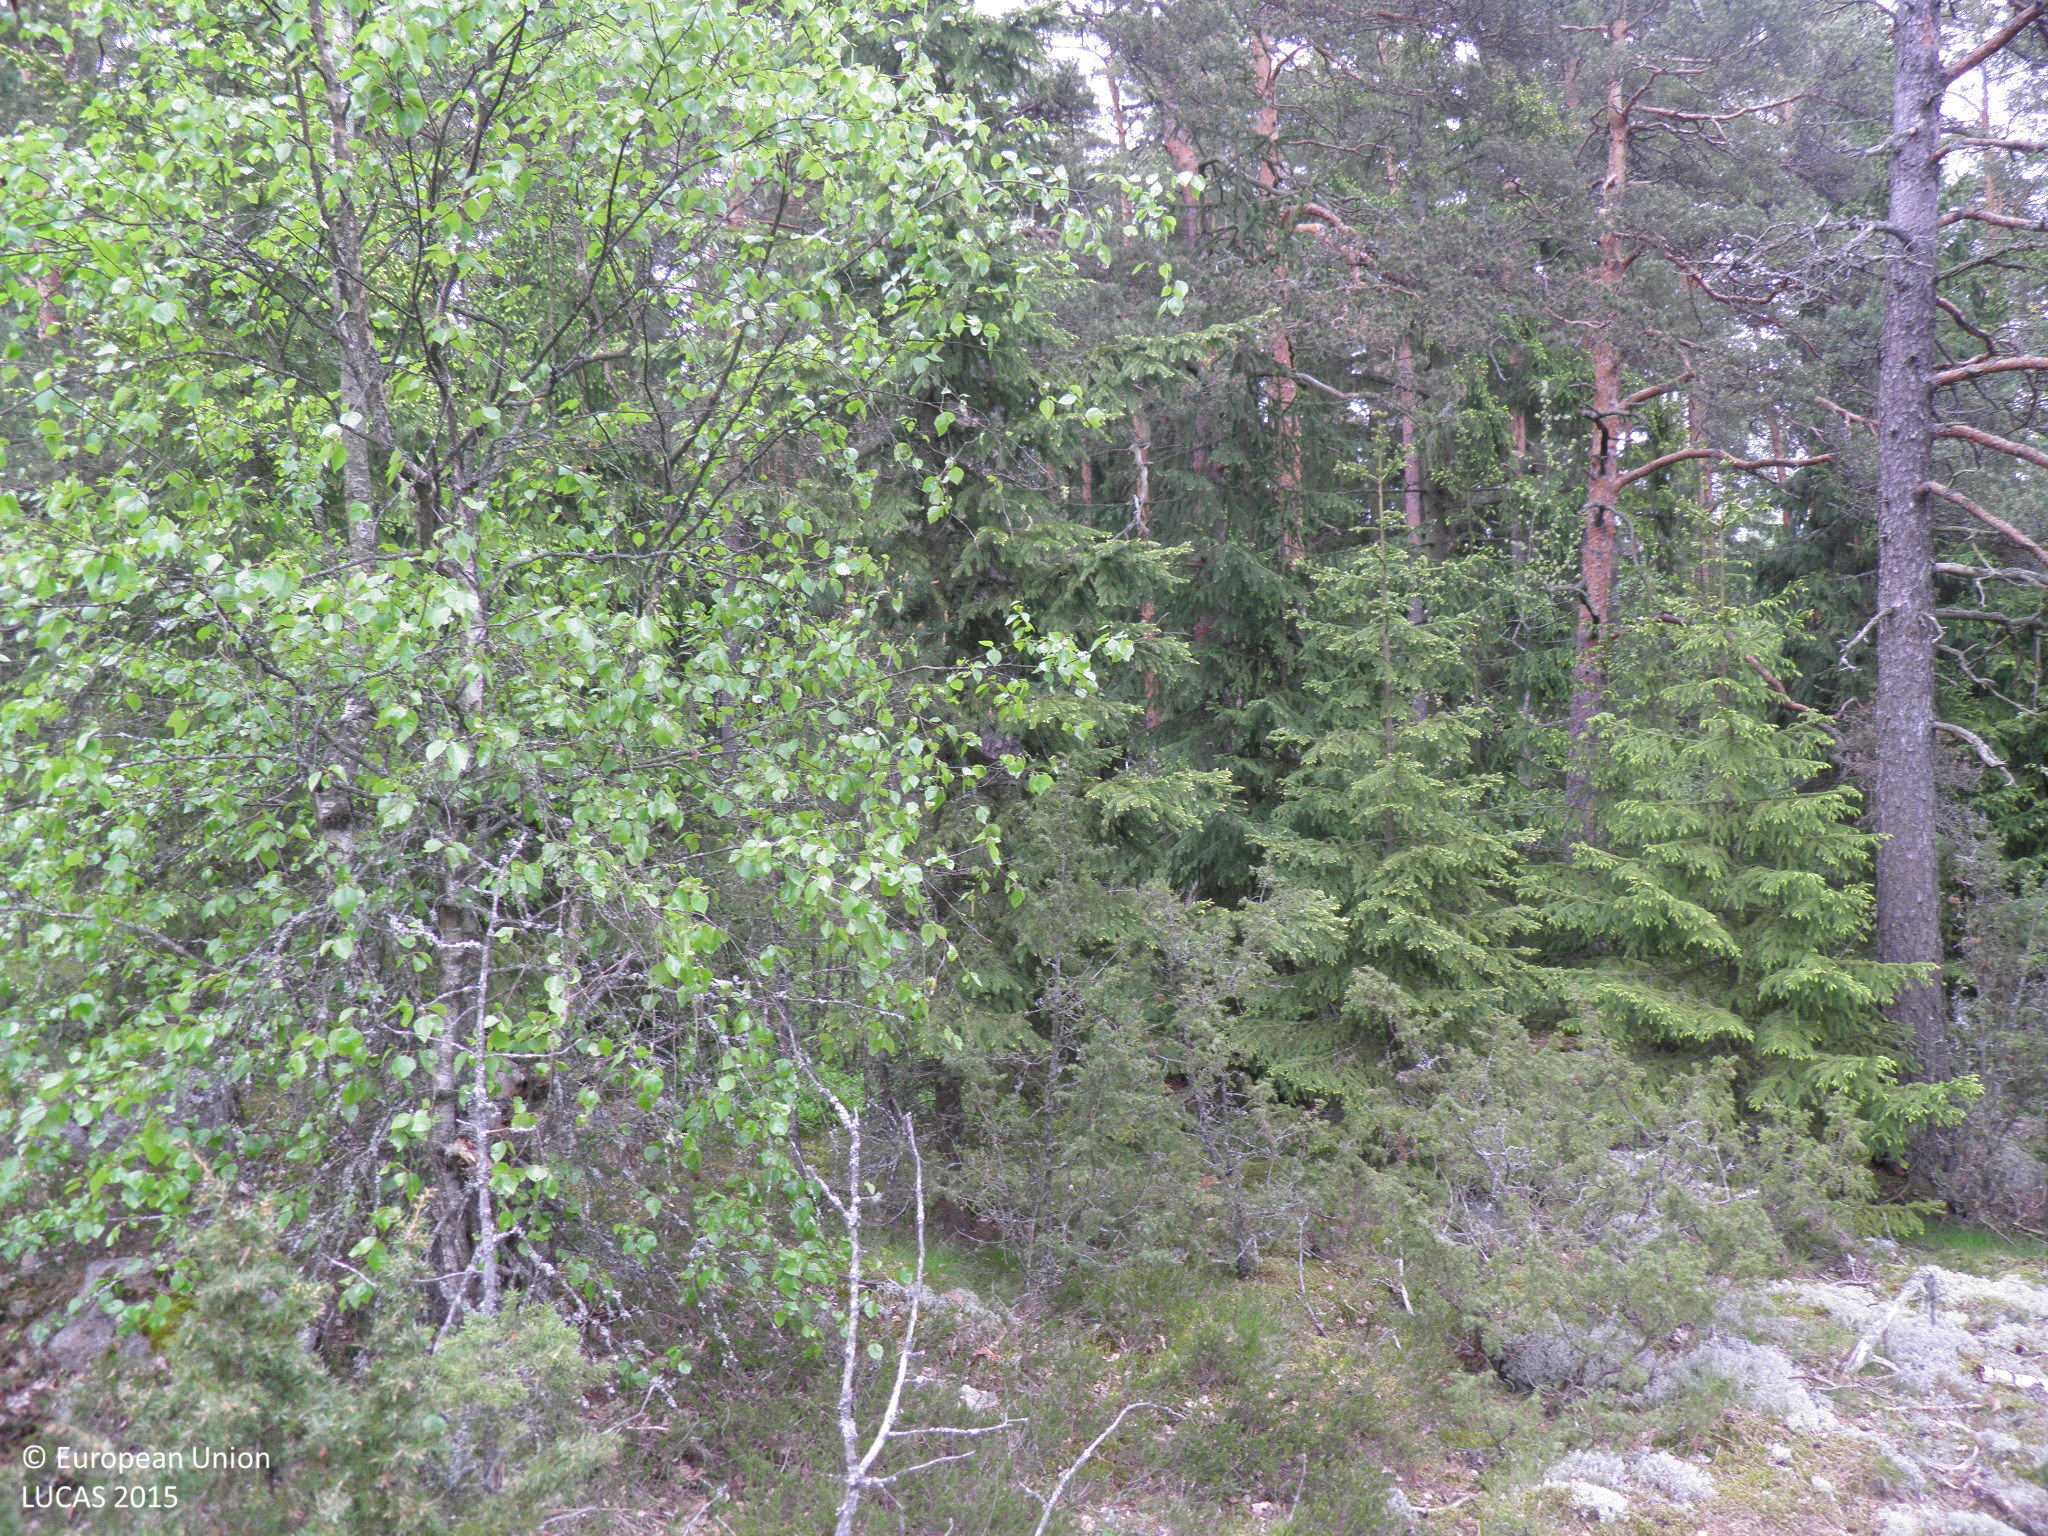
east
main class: Woodland
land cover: Pine dominated coniferous woodland
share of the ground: > 75 %
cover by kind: coniferous forest trees 80 %, broadleaved forest trees 10 %, shrubs 5 %, herbaceous plants 5 %
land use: Forestry
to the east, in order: Pine dominated coniferous woodland; Spruce dominated coniferous woodland; Tracks; Electric lines; Ditches and canals; Other mixed woodland; Tracks; Grassland without tree/shrub cover; Artificial constructions in urban areas; Pine dominated coniferous woodland; Pine dominated mixed woodland
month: June
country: FI
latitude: 60.5108
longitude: 22.3609
